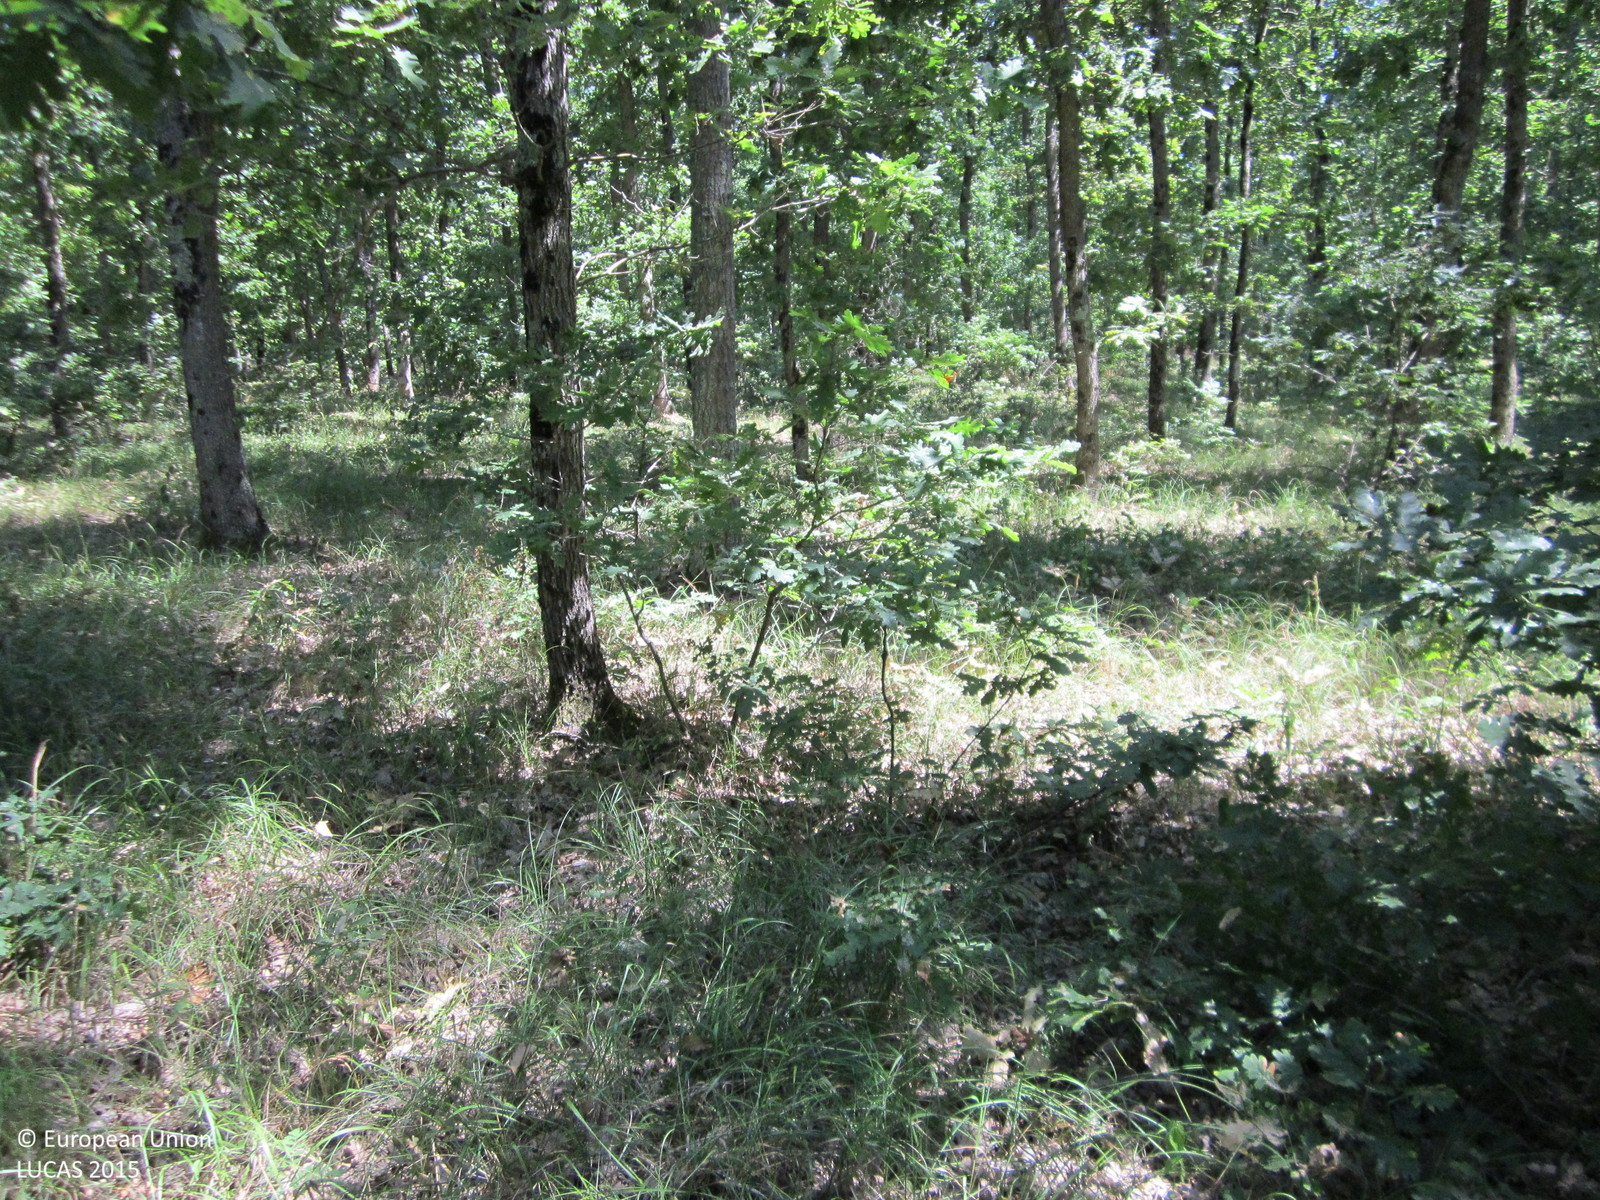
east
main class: Woodland
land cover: Broadleaved woodland
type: thermophilous deciduous forest
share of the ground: > 75 %
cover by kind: broadleaved forest trees 80 %, herbaceous plants 20 %
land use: Forestry
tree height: > 5 m
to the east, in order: Broadleaved woodland; Tracks; Broadleaved woodland; Rivers and streams; Broadleaved woodland
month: August
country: BG
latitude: 42.8492
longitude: 27.8136
